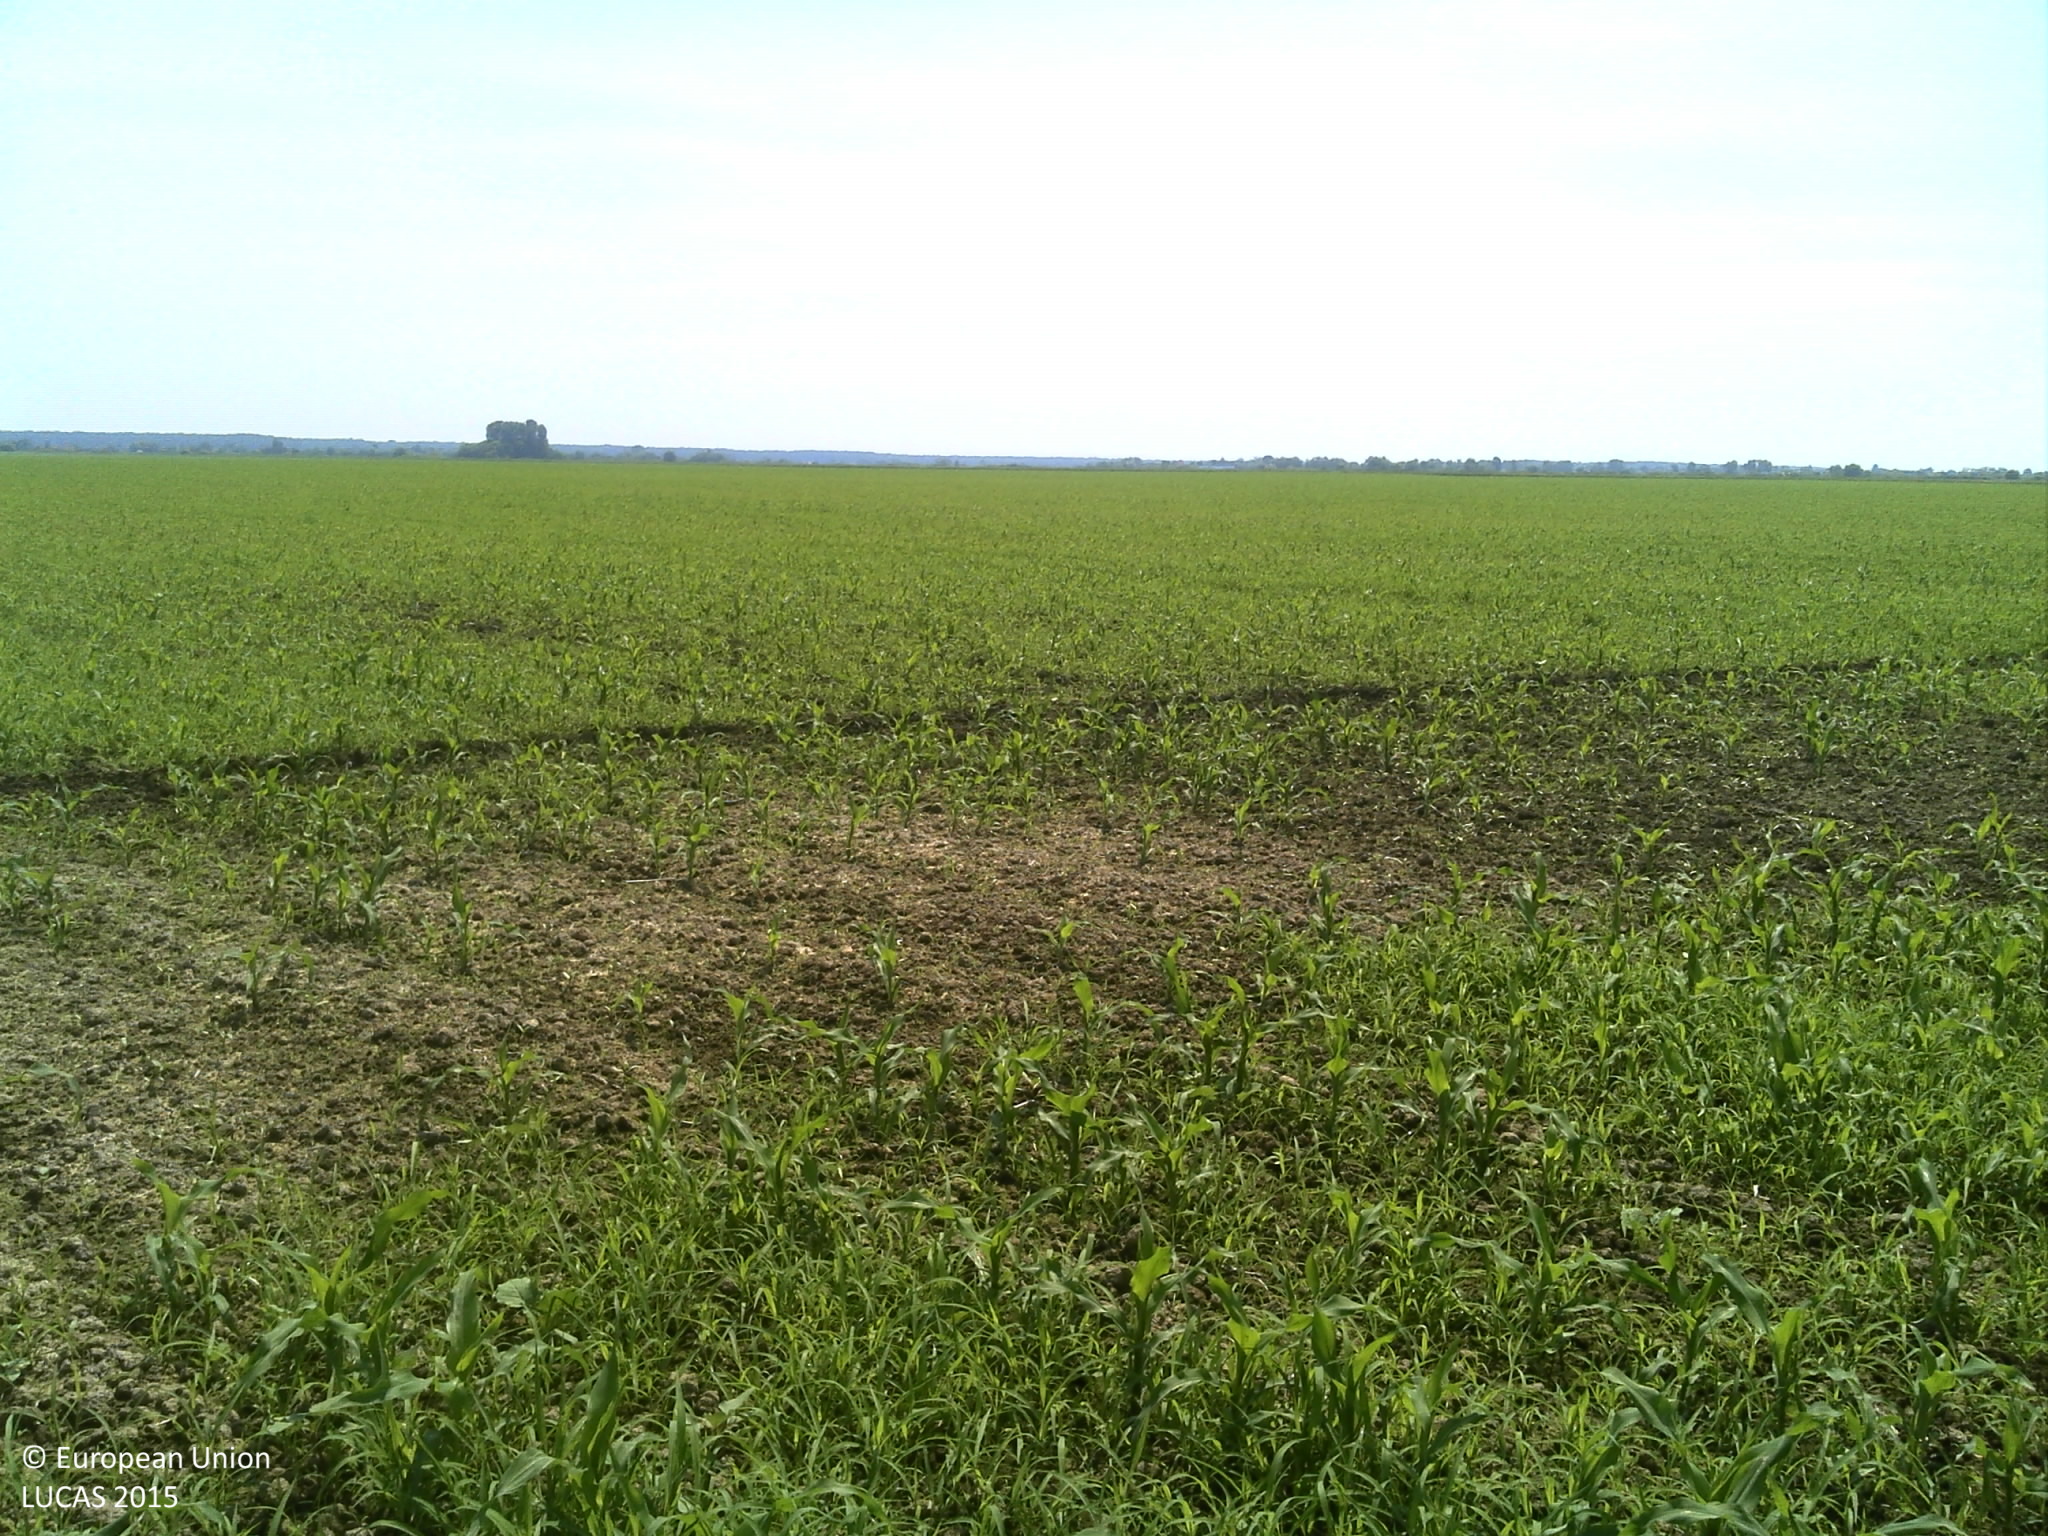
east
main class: Cropland
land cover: Maize
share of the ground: 25 - 50 %
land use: Agriculture (excluding fallow land and kitchen gardens)
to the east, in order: Maize
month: June
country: HR
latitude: 45.6749
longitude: 17.9506
